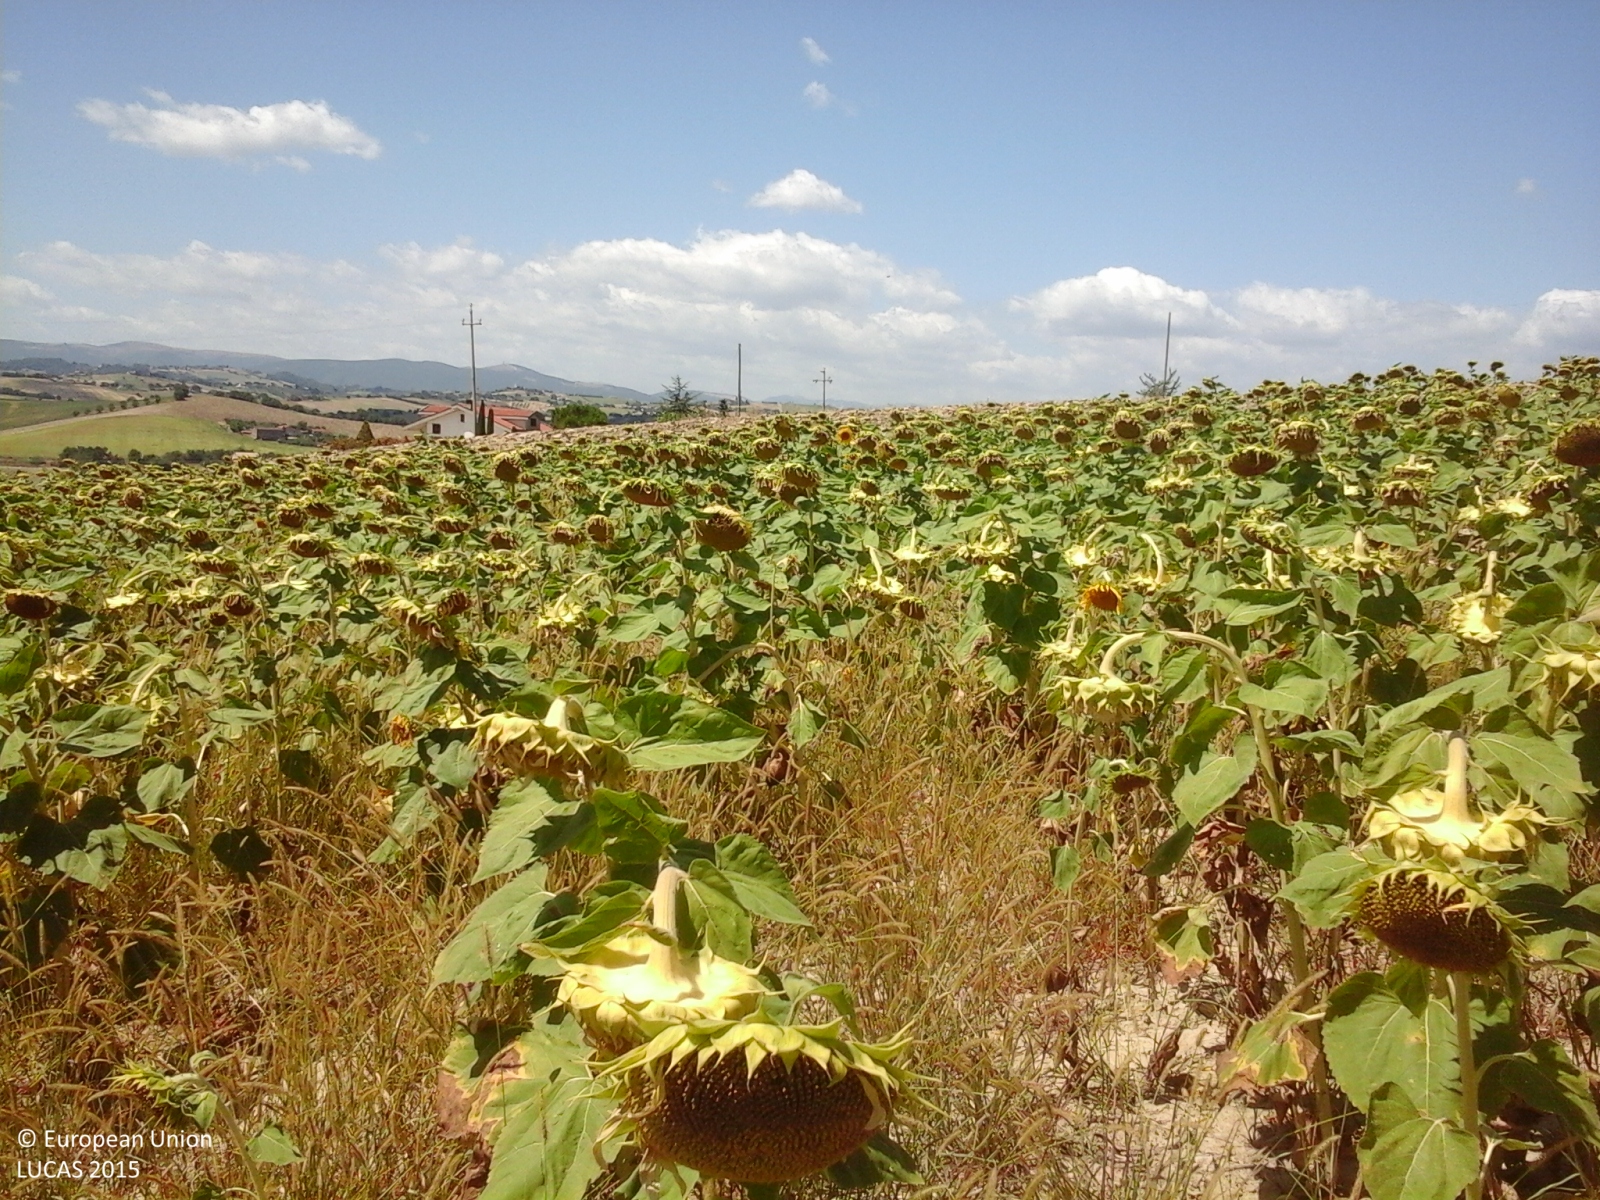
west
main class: Cropland
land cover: Sunflower
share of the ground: > 75 %
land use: Agriculture (excluding fallow land and kitchen gardens)
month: July
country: IT
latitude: 43.2498
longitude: 13.3291
